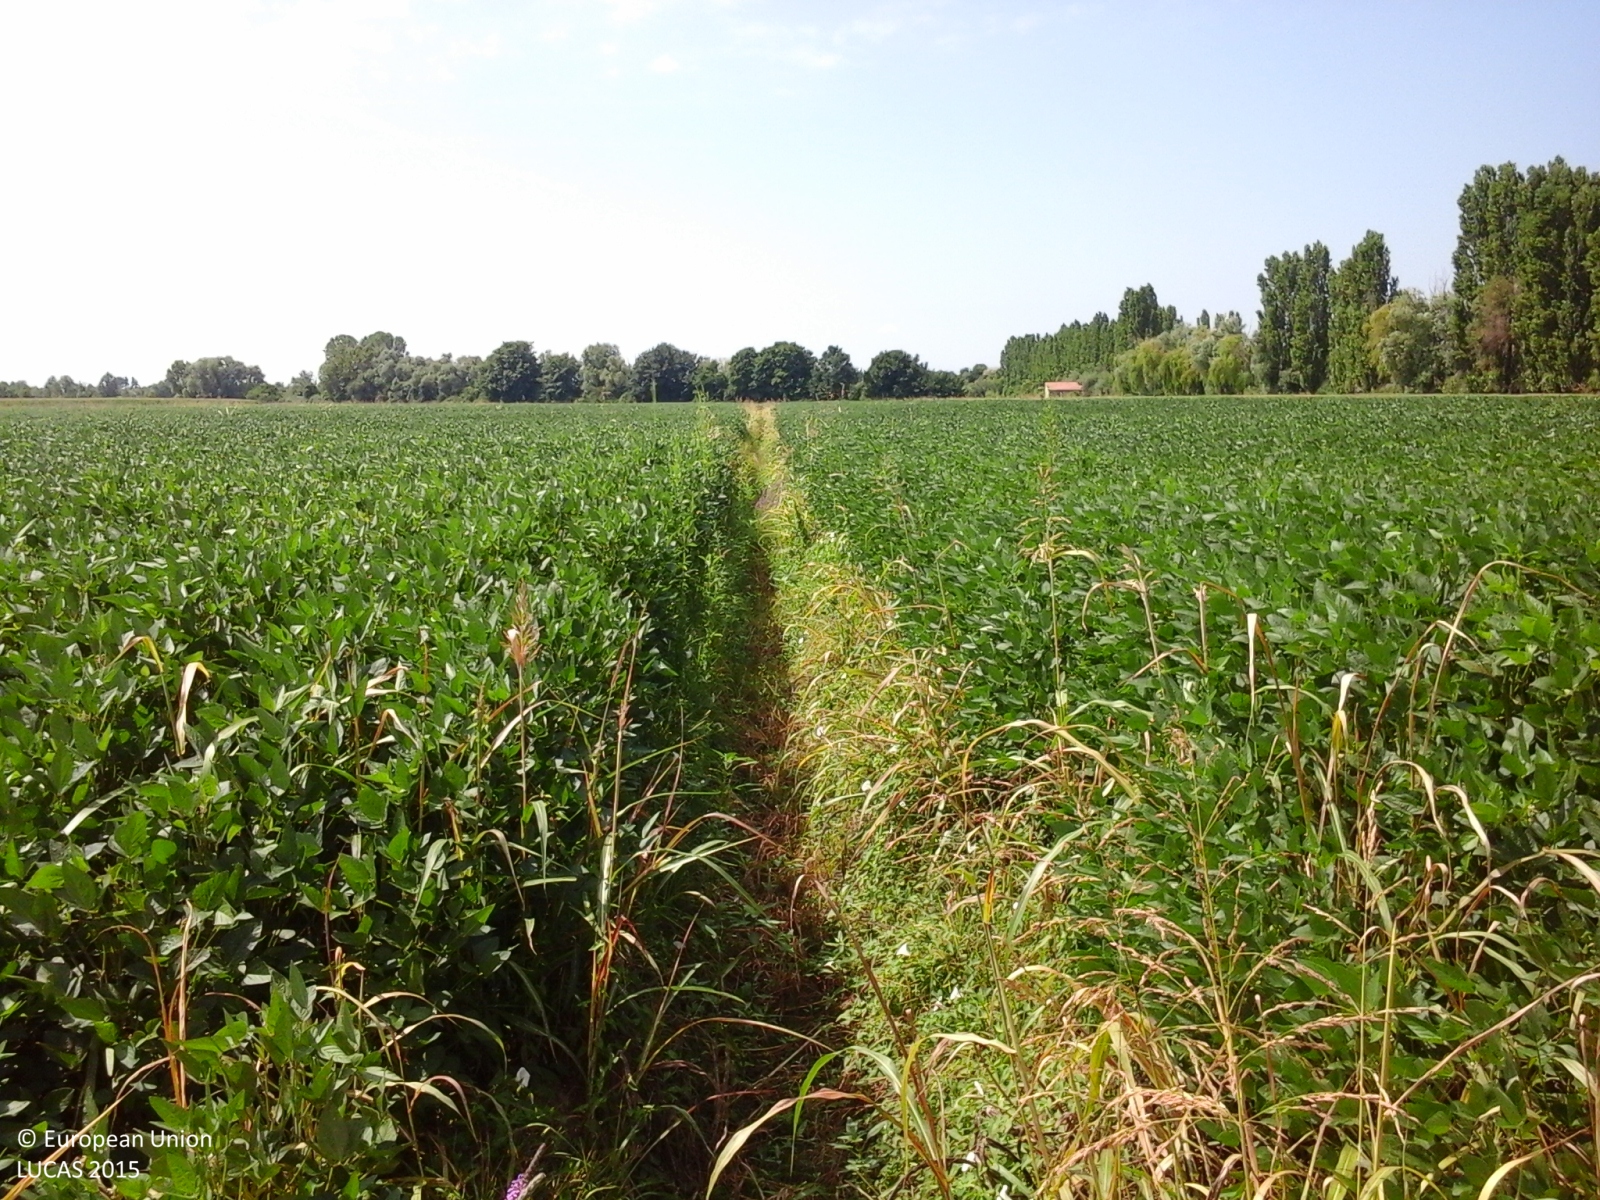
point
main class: Cropland
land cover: Soya
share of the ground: < 10 %
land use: Agriculture (excluding fallow land and kitchen gardens)
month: May
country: IT
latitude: 45.5686
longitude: 12.3413
